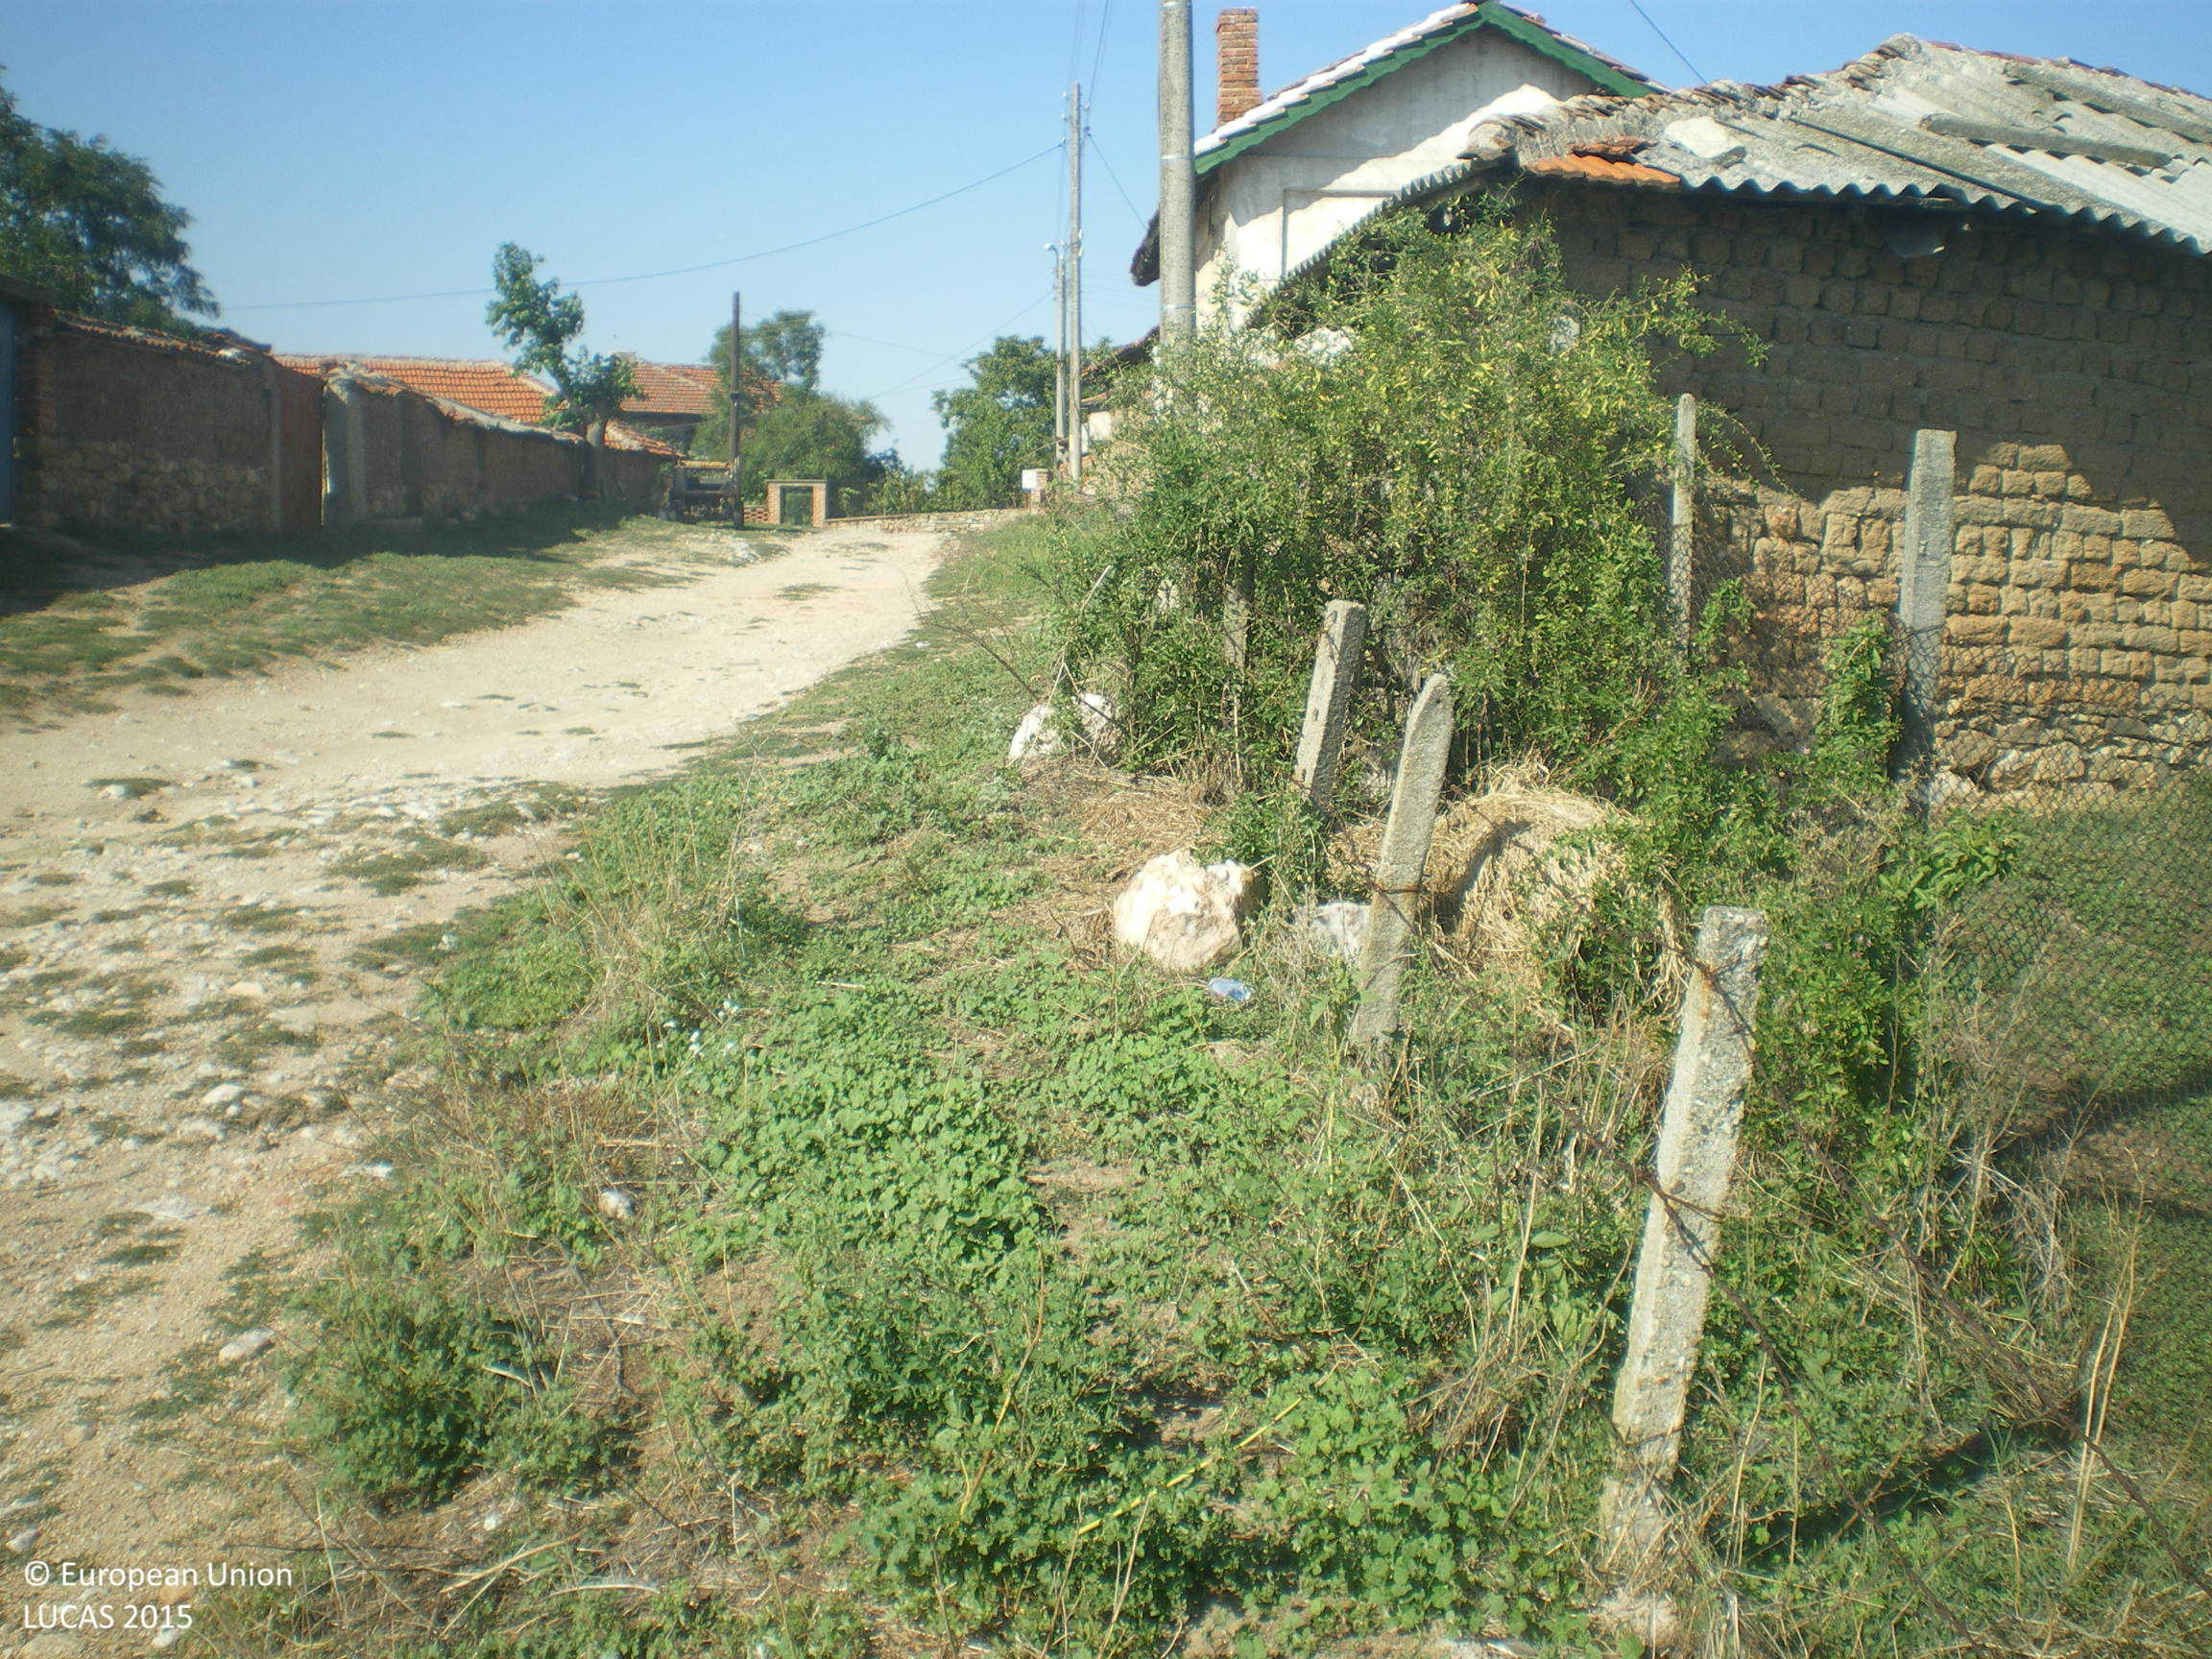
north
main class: Grassland
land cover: Grassland without tree/shrub cover
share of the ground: > 75 %
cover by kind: herbaceous plants 100 %
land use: Residential
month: September
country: BG
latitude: 41.8479
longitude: 25.7855
